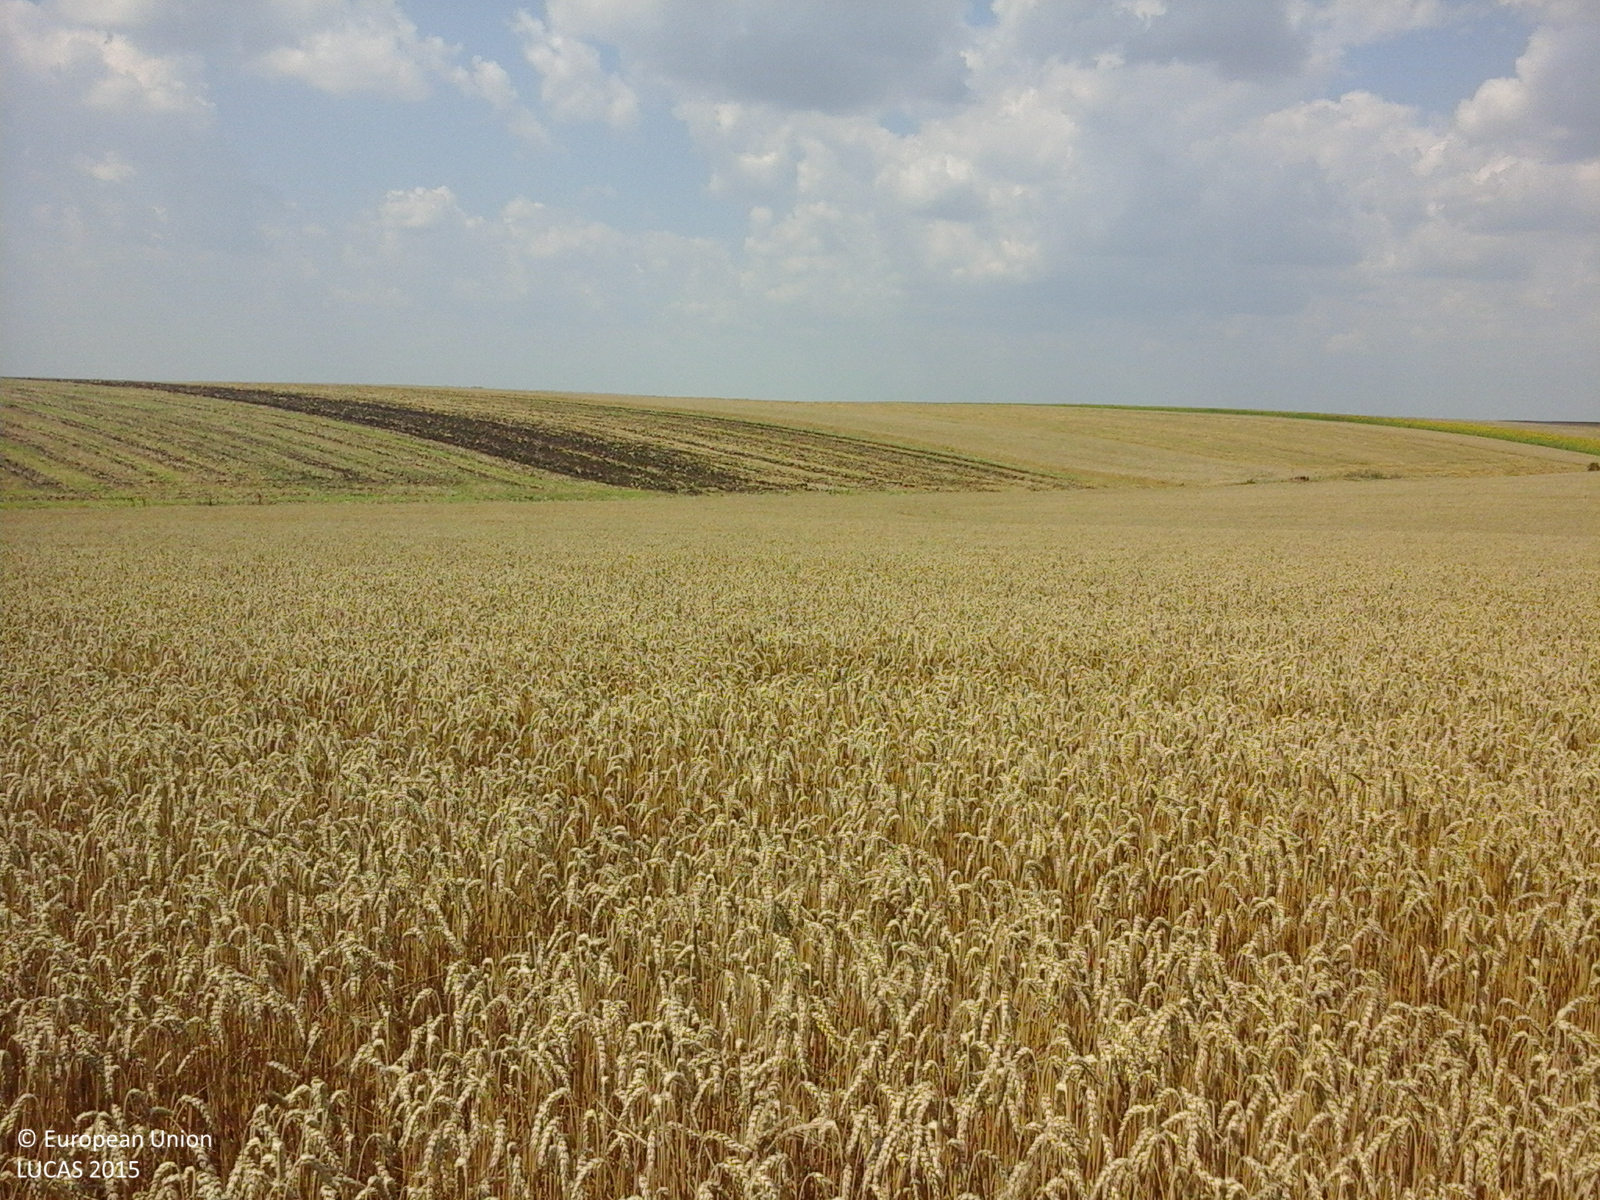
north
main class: Cropland
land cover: Common wheat
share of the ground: > 75 %
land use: Agriculture (excluding fallow land and kitchen gardens)
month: July
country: RO
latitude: 43.9780
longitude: 25.1763
